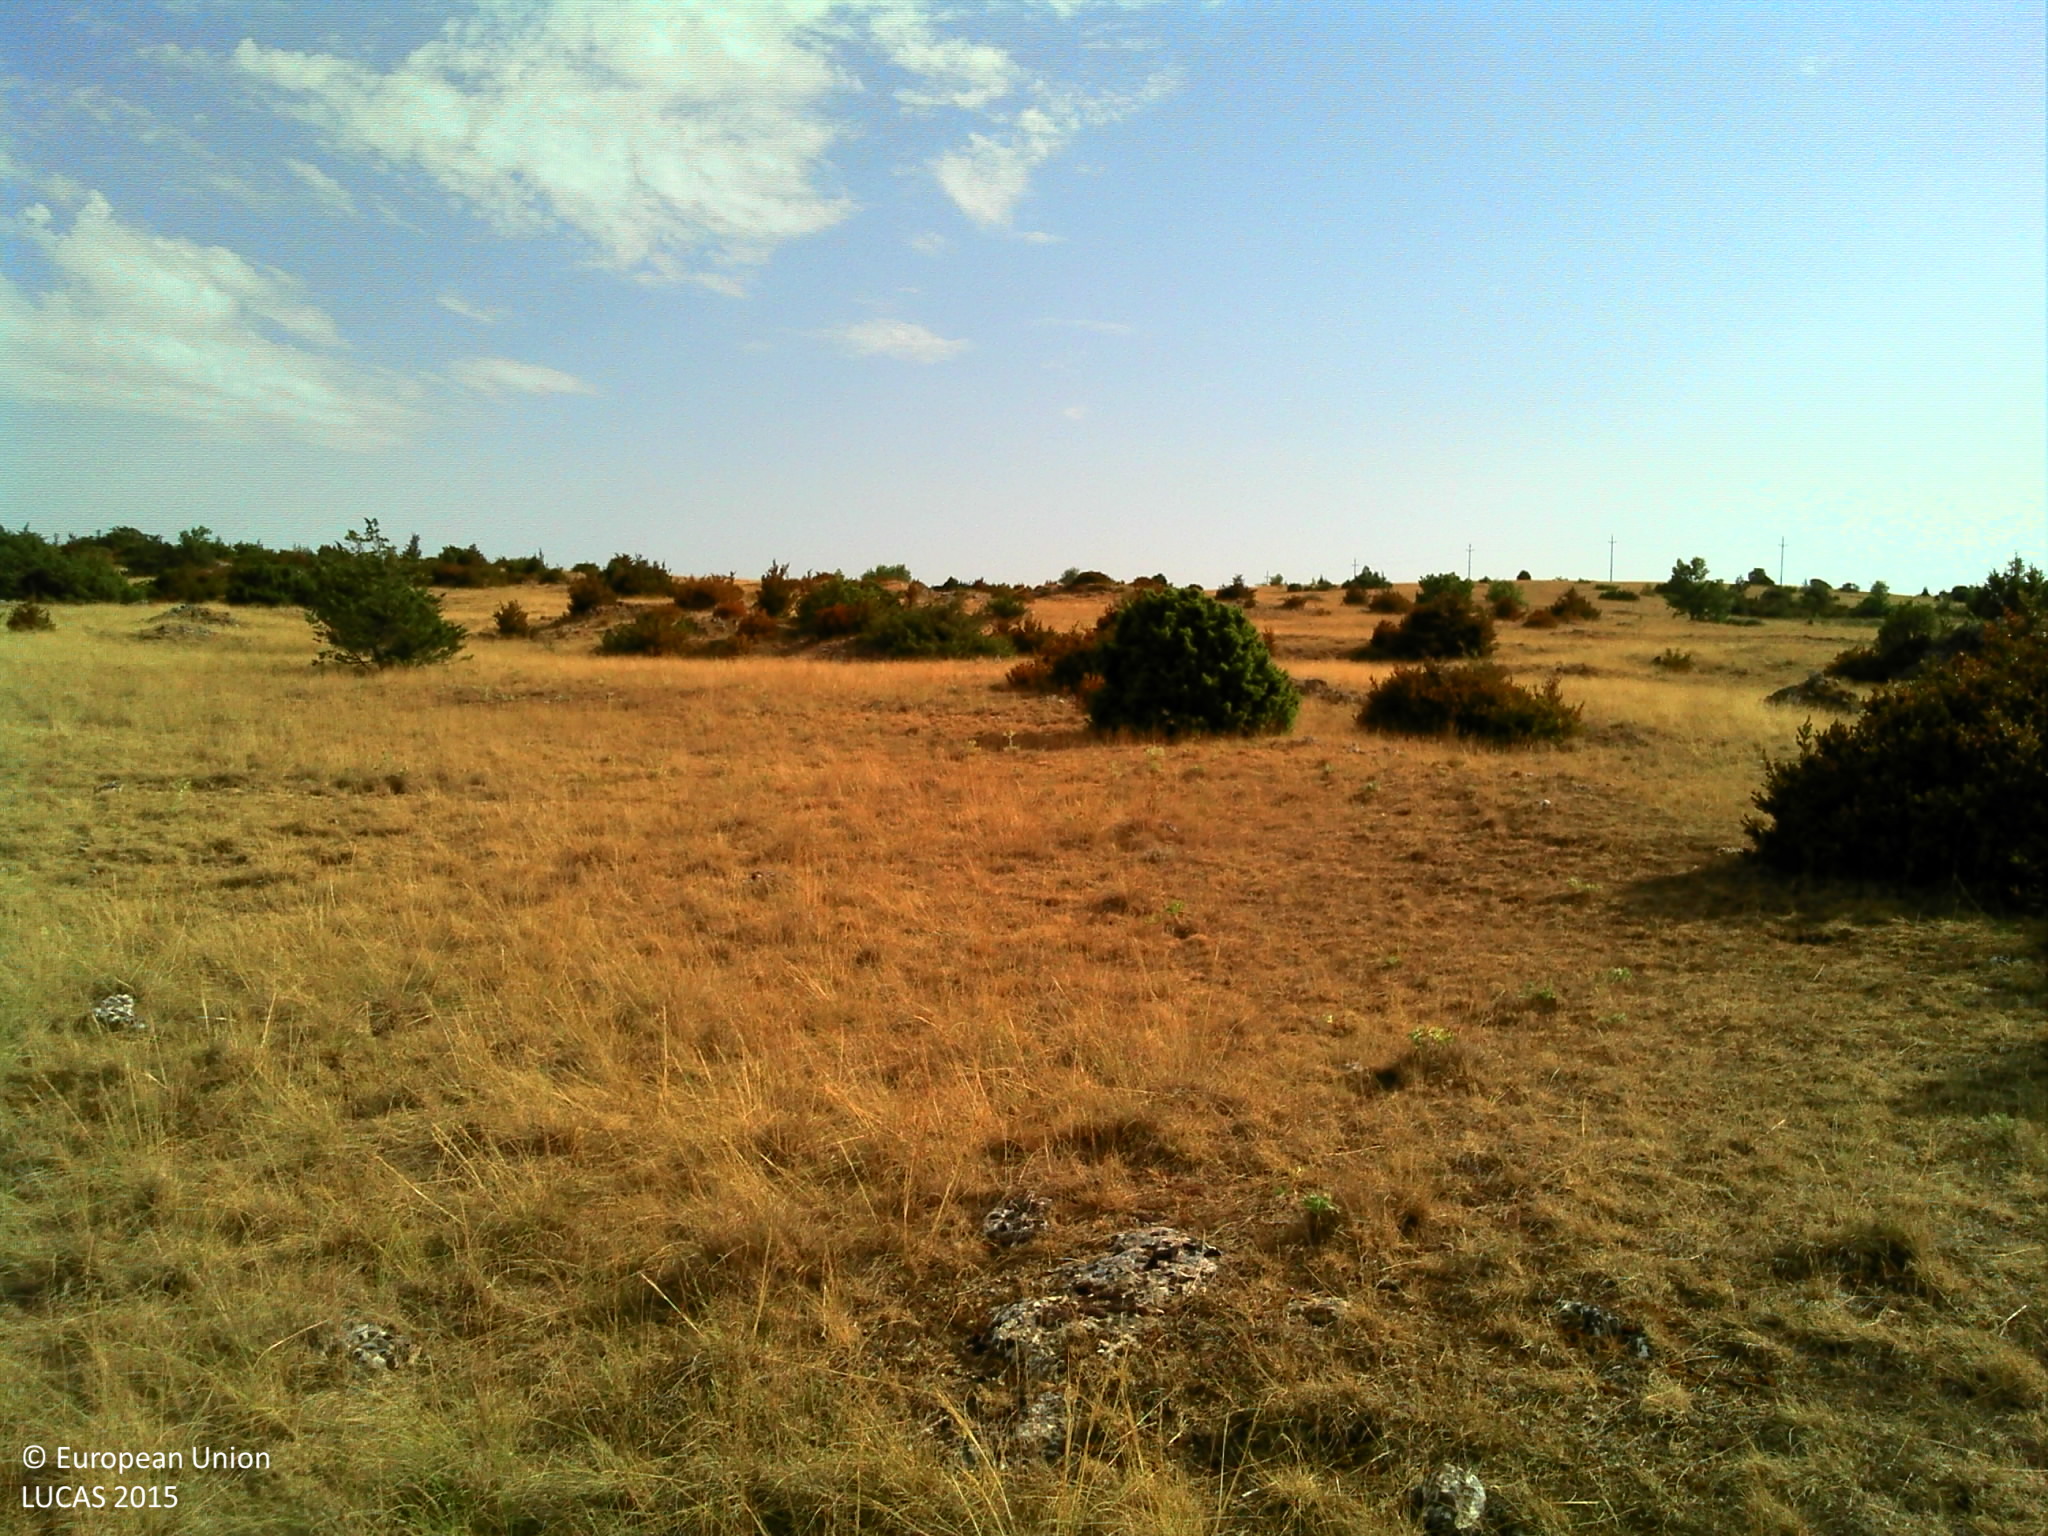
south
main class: Grassland
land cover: Grassland with sparse tree/shrub cover
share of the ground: > 75 %
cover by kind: herbaceous plants 85 %, broadleaved forest trees 5 %, shrubs 5 %, consolidated bare surface 5 %
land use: Agriculture (excluding fallow land and kitchen gardens)
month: August
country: FR
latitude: 43.9622
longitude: 3.1645
